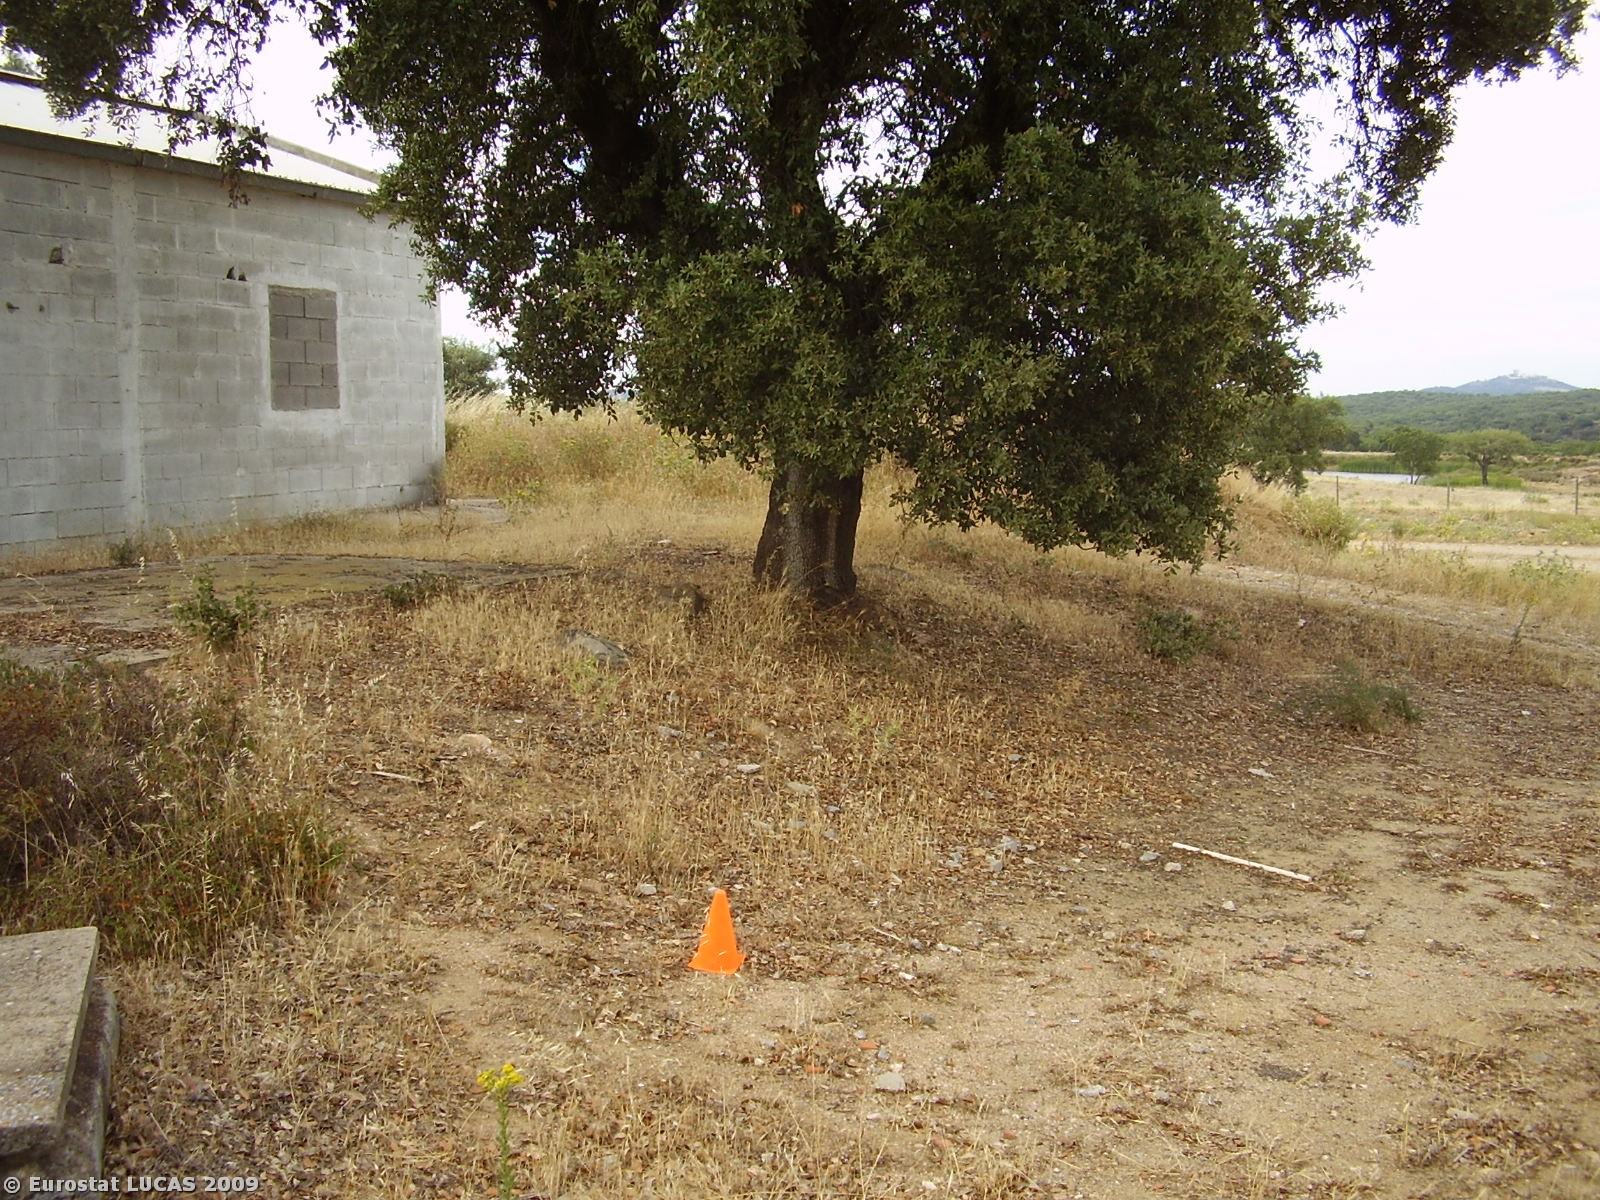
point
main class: Woodland
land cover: Broadleaved woodland
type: broadleaved evergreen forest
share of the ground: 10 - 25 %
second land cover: Bare land
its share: 50 - 75 %
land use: Forestry
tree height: > 5 m
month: July
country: PT
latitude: 38.7197
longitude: -7.7861
